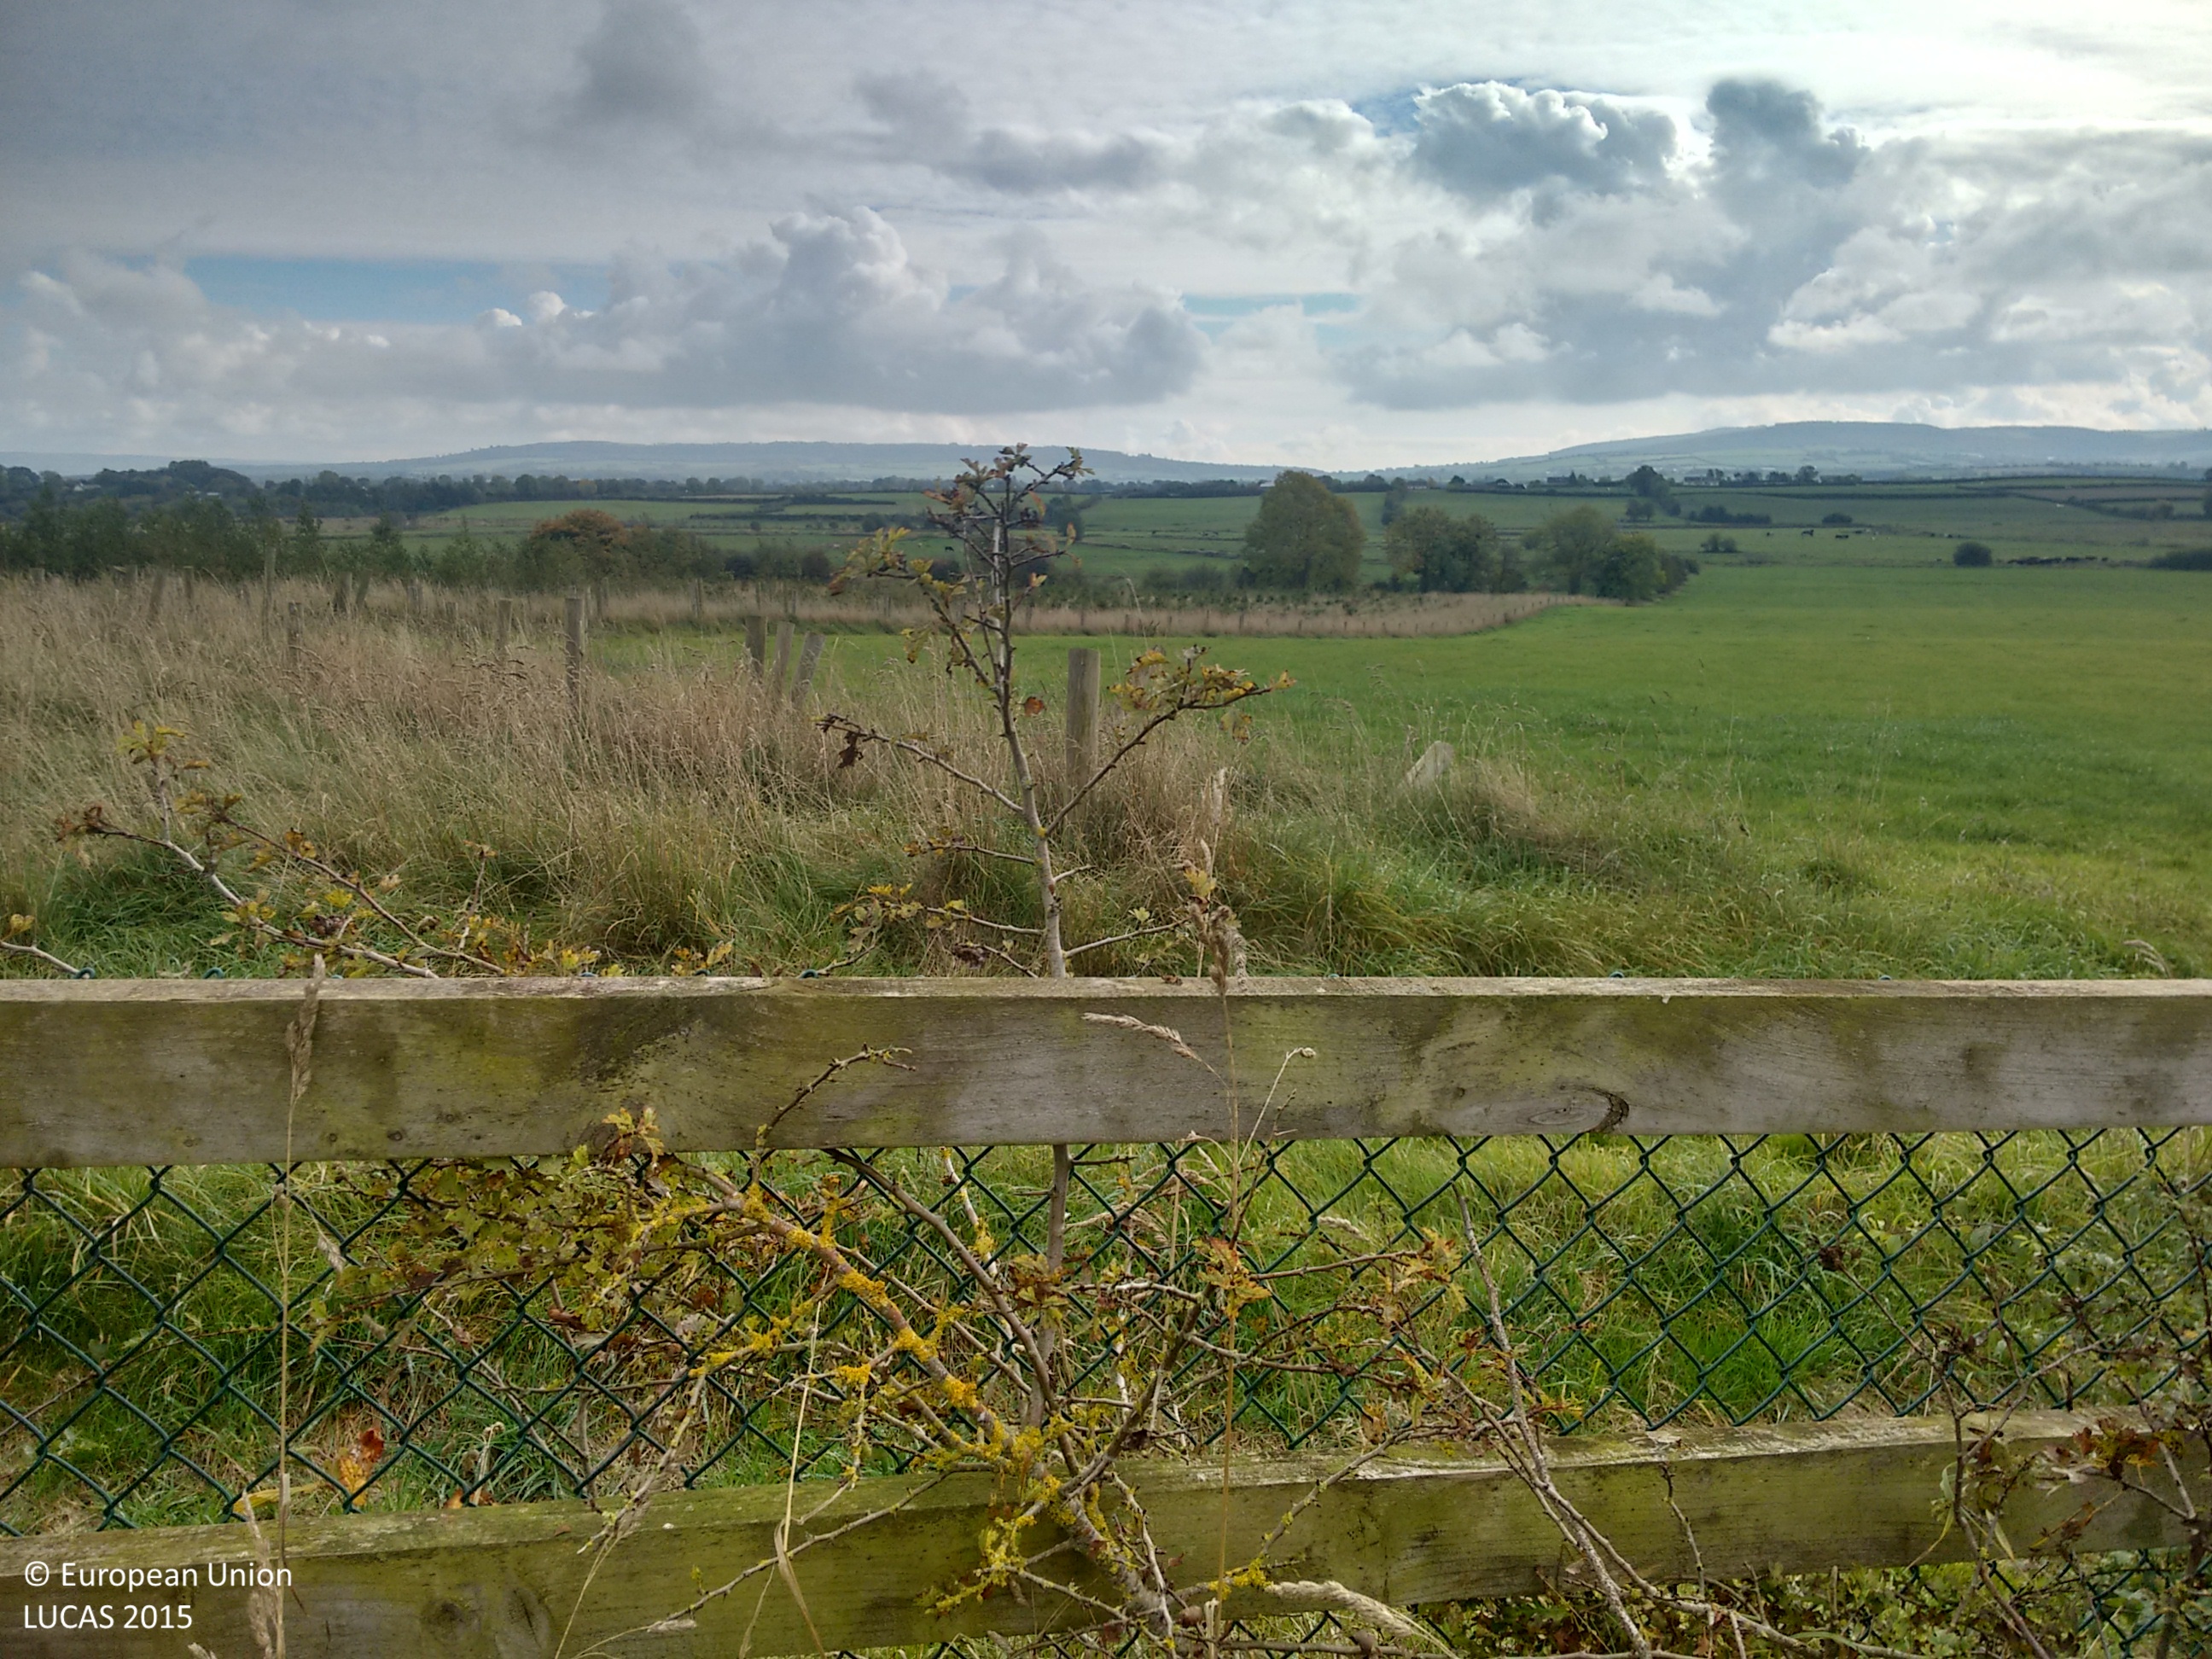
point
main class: Woodland
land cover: Broadleaved woodland
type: mesophytic deciduous forest
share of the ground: > 75 %
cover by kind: broadleaved forest trees 65 %, herbaceous plants 35 %
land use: Forestry
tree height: > 5 m
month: October
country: IE
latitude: 52.8515
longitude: -7.4879
